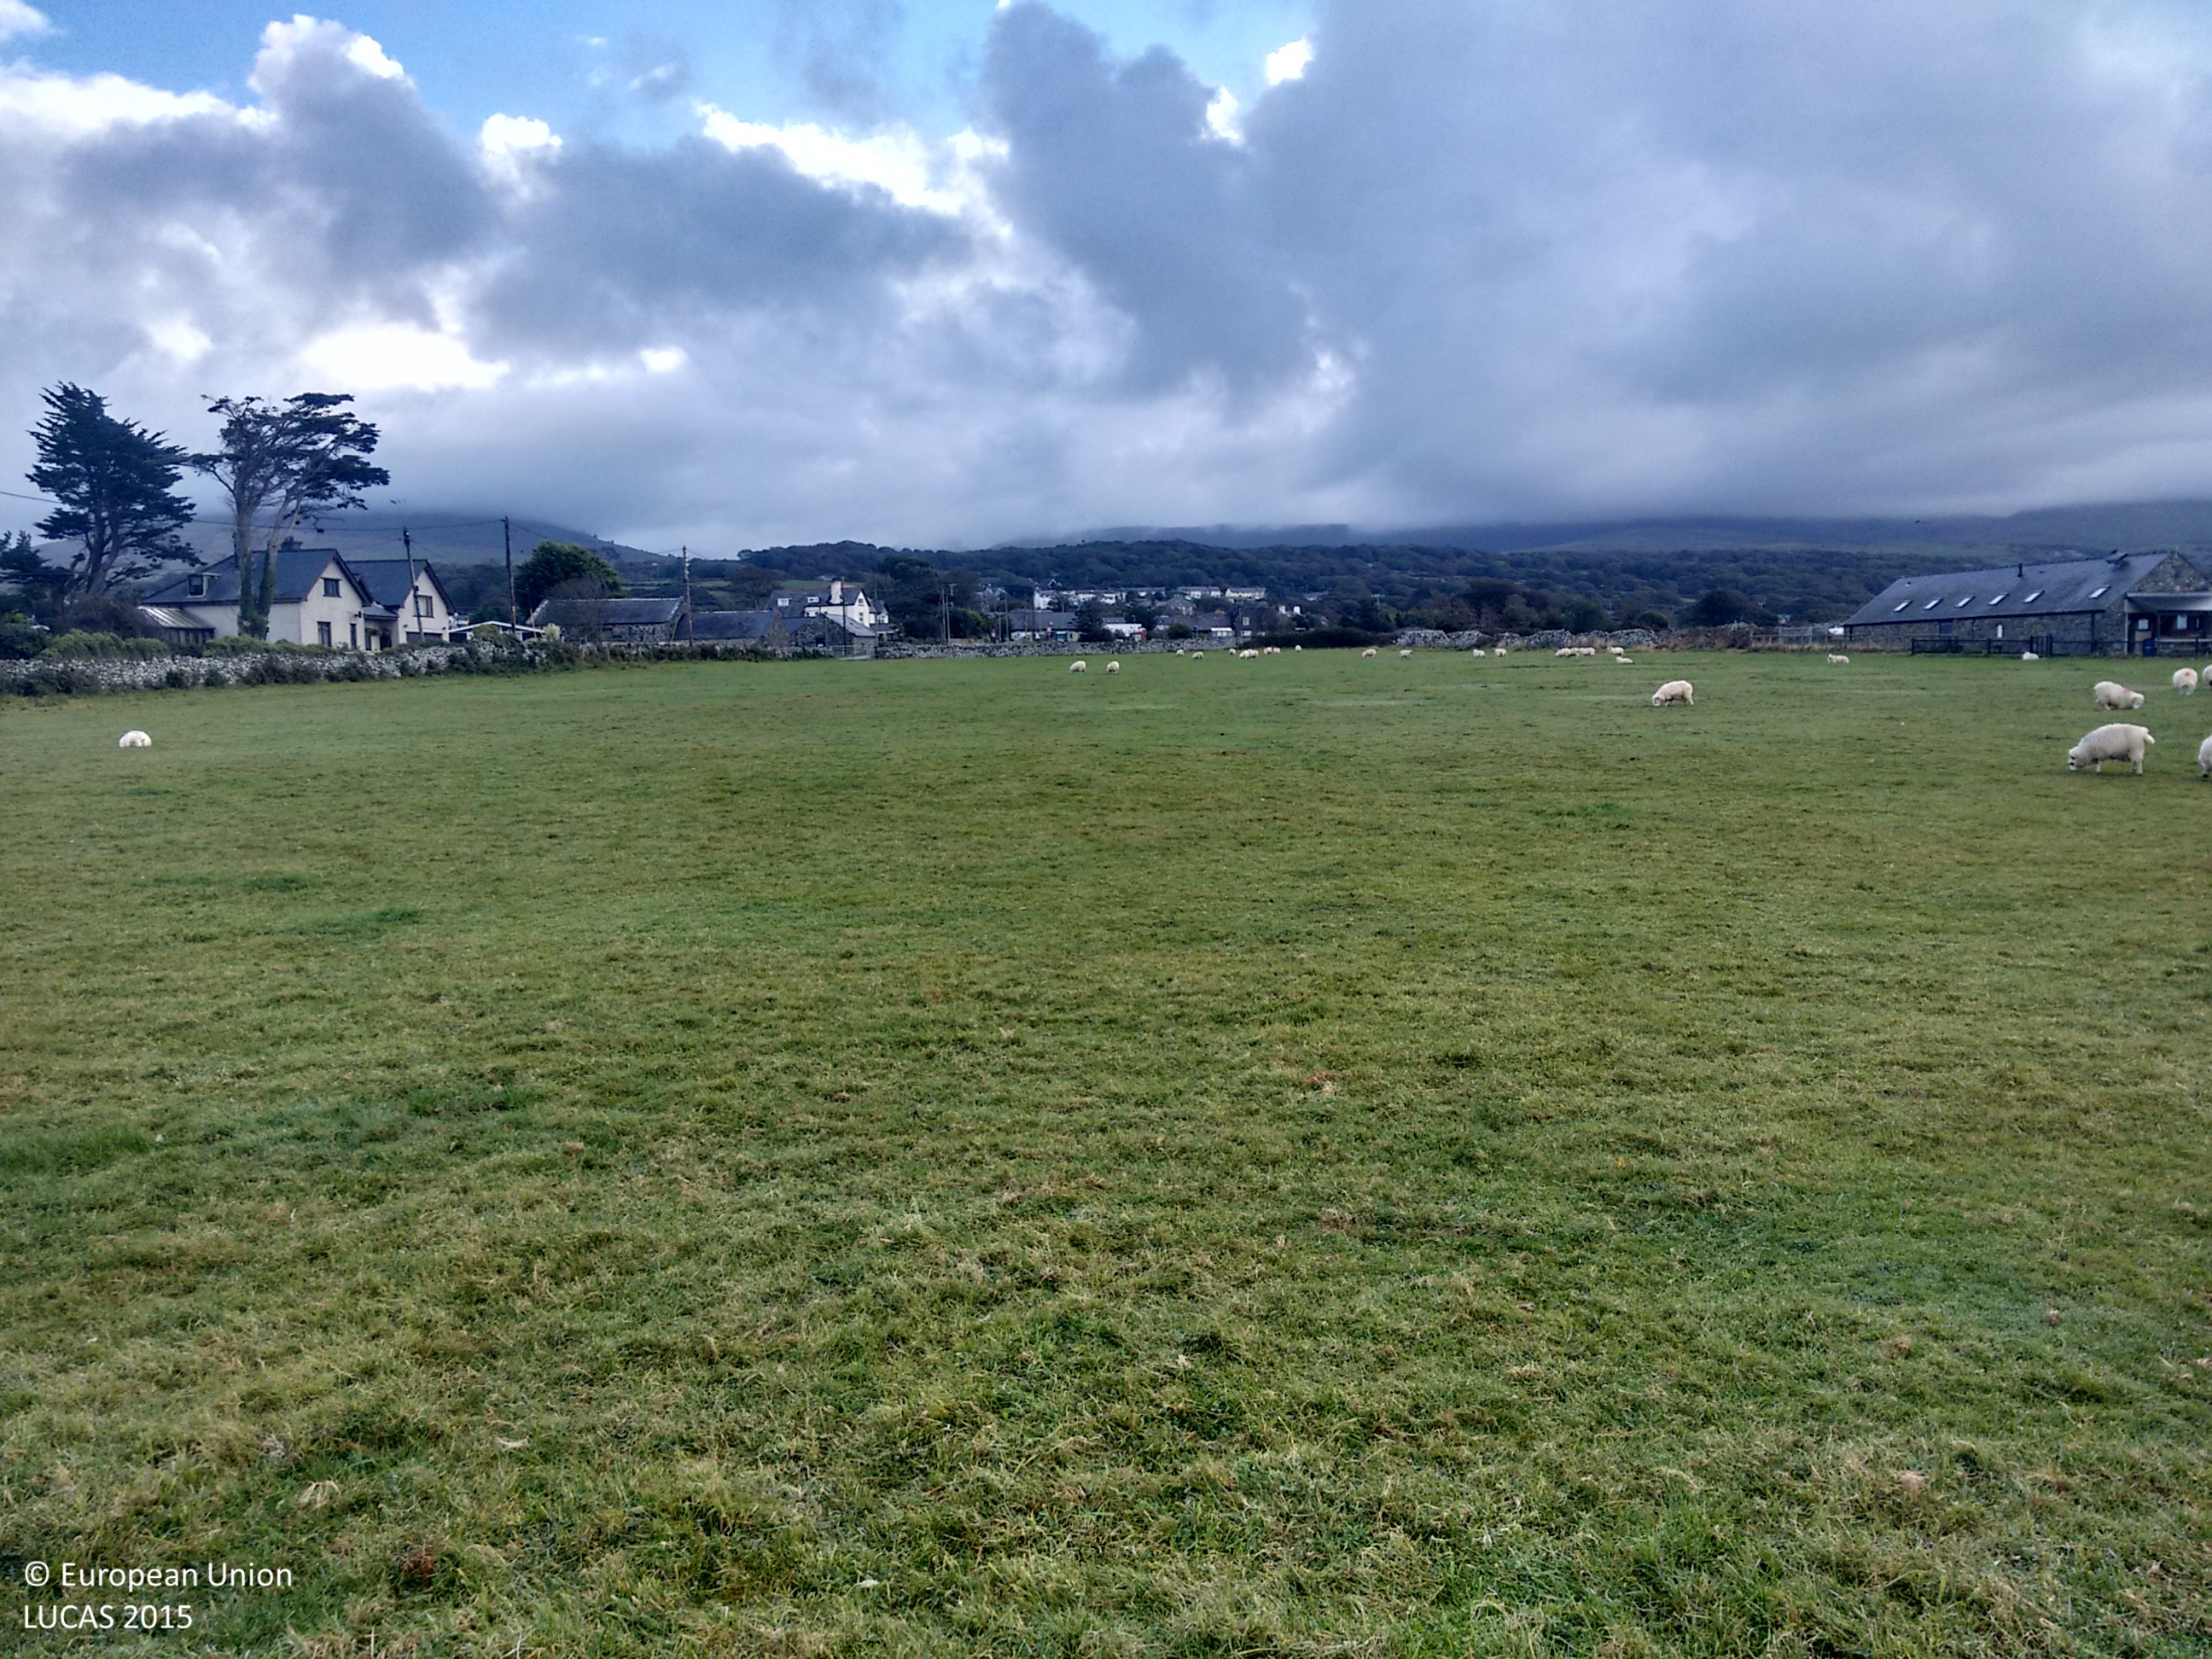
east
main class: Grassland
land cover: Grassland without tree/shrub cover
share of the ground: > 75 %
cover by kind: herbaceous plants 100 %
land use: Agriculture (excluding fallow land and kitchen gardens)
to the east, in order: Managed hedges; Fences; Grassland without tree/shrub cover; Fences; Grass margins; Artificial constructions in urban areas
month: October
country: GB
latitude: 52.7893
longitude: -4.1096
